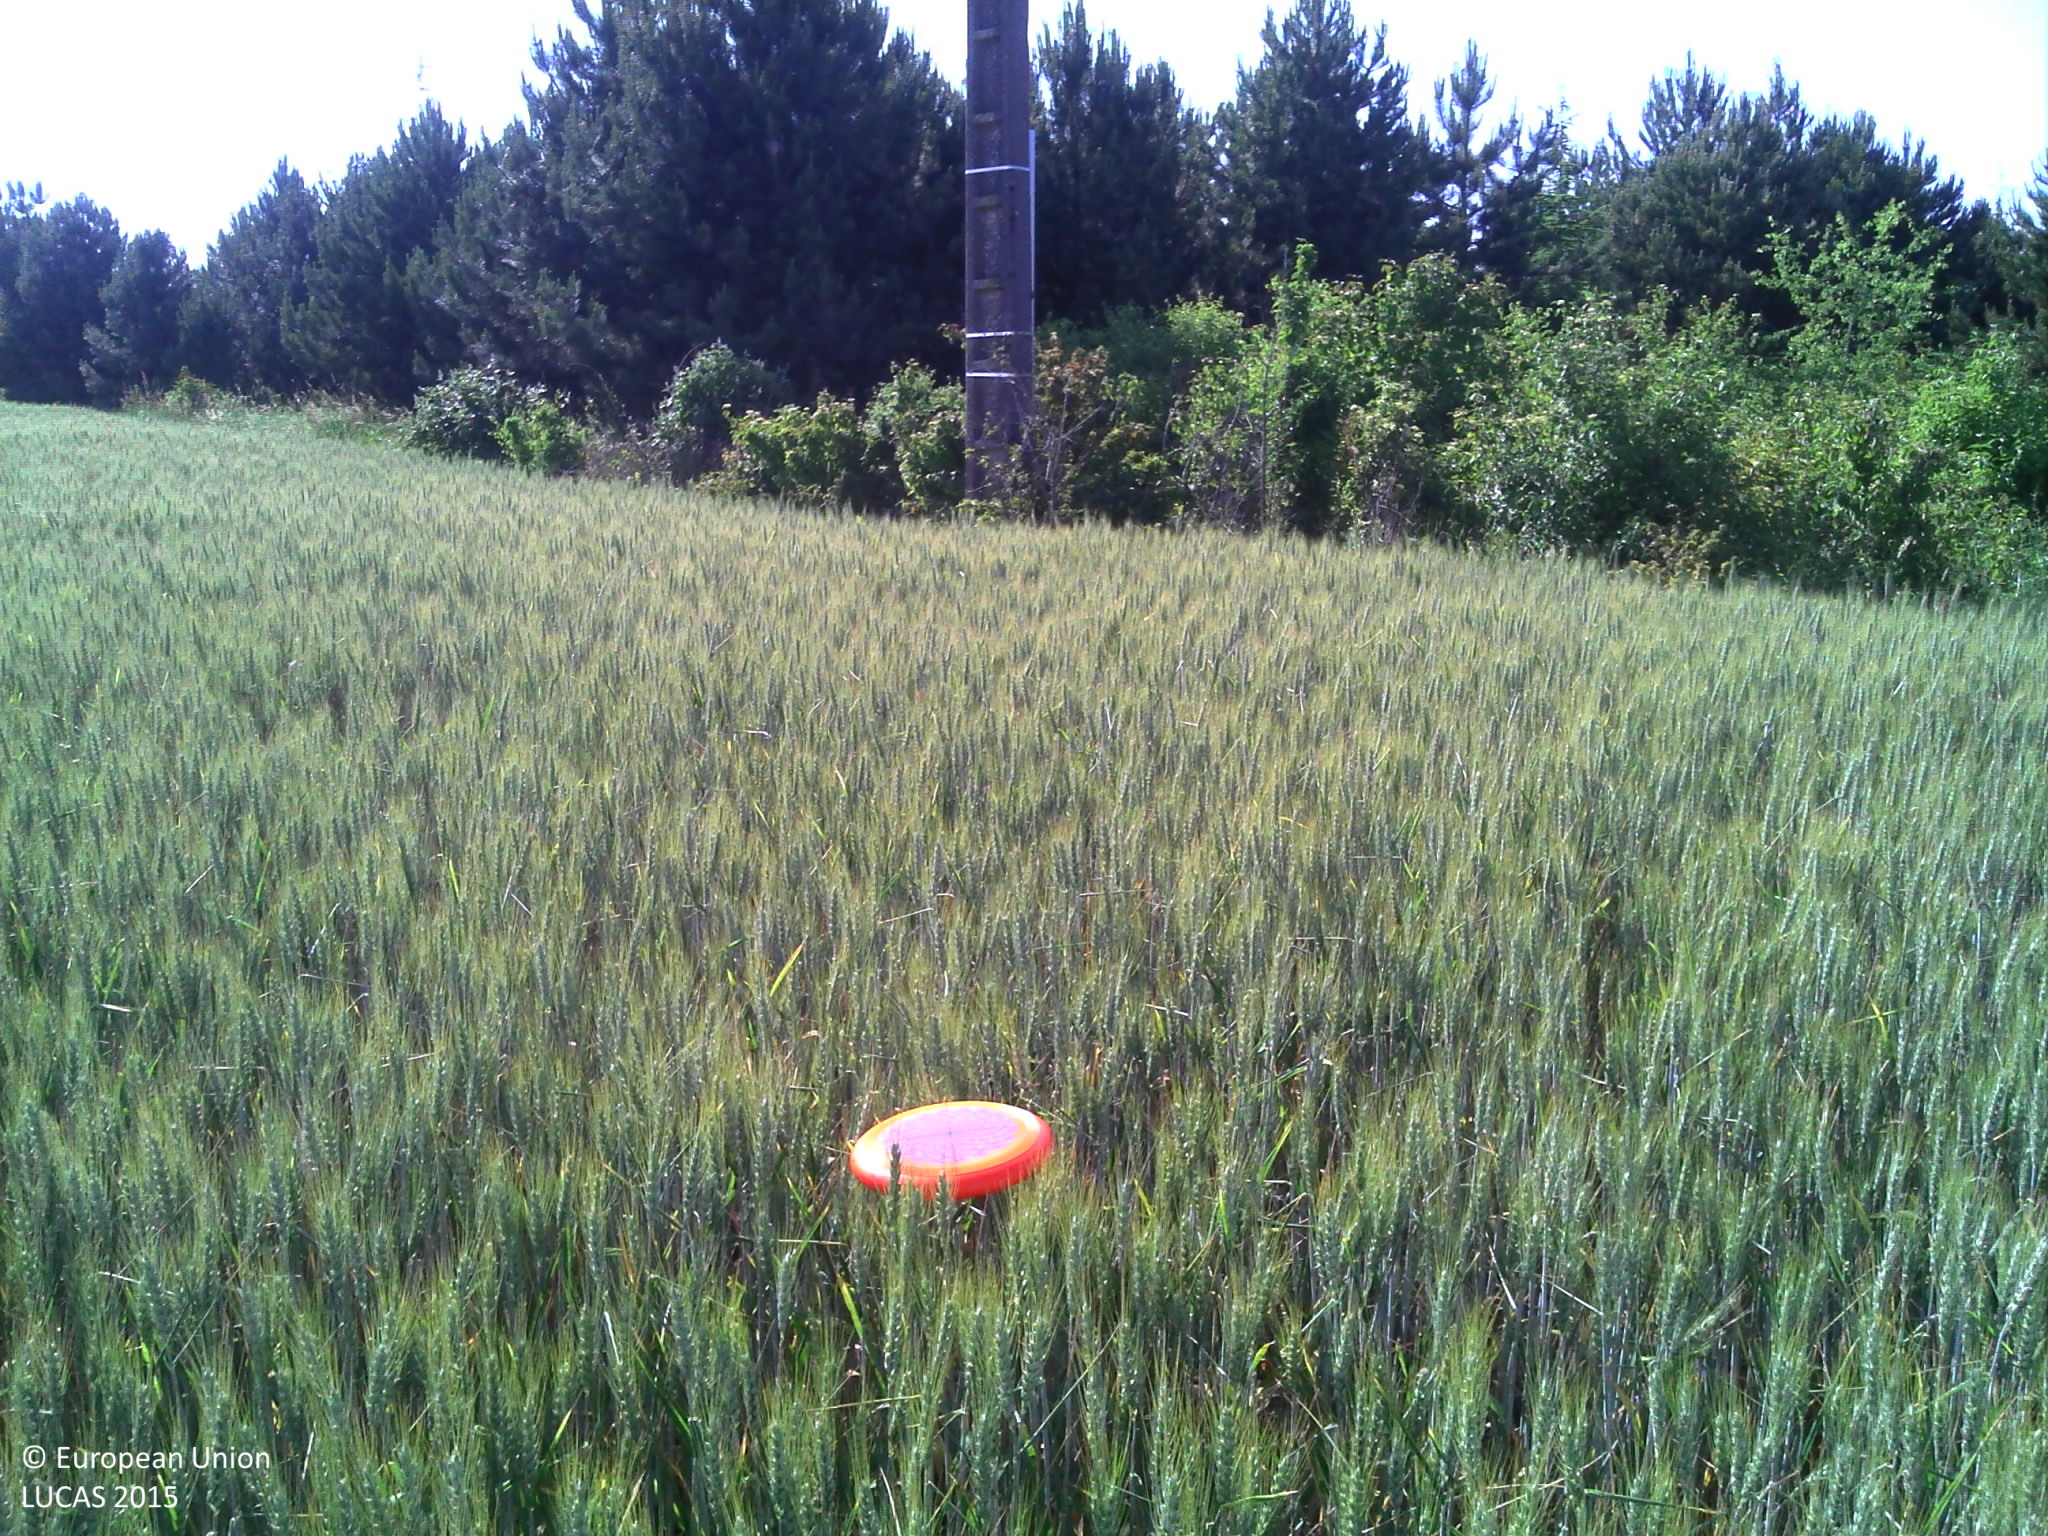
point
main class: Cropland
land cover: Common wheat
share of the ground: > 75 %
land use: Agriculture (excluding fallow land and kitchen gardens)
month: June
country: FR
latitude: 47.6015
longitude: 3.8655
